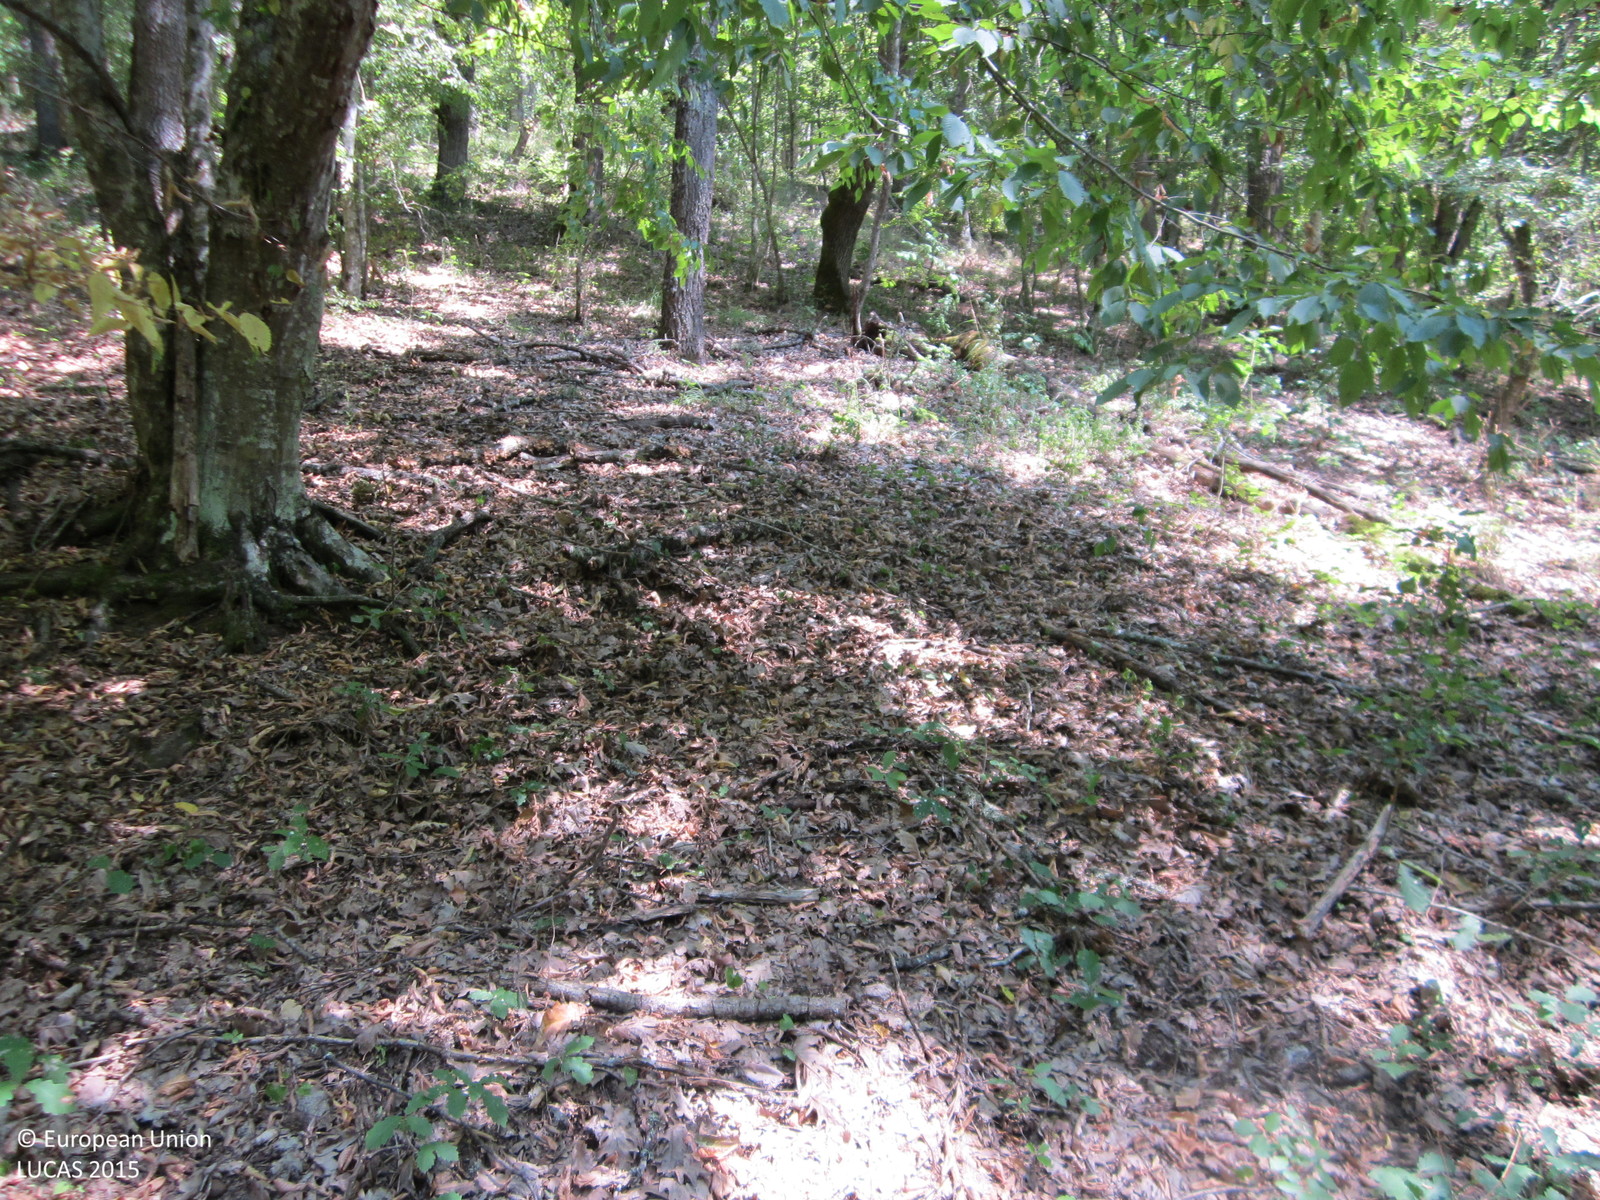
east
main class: Woodland
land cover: Broadleaved woodland
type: beech forest
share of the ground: > 75 %
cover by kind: broadleaved forest trees 95 %, unconsolidated bare surface 5 %
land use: Forestry
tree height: > 5 m
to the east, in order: Broadleaved woodland
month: August
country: BG
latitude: 42.0701
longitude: 27.5285
